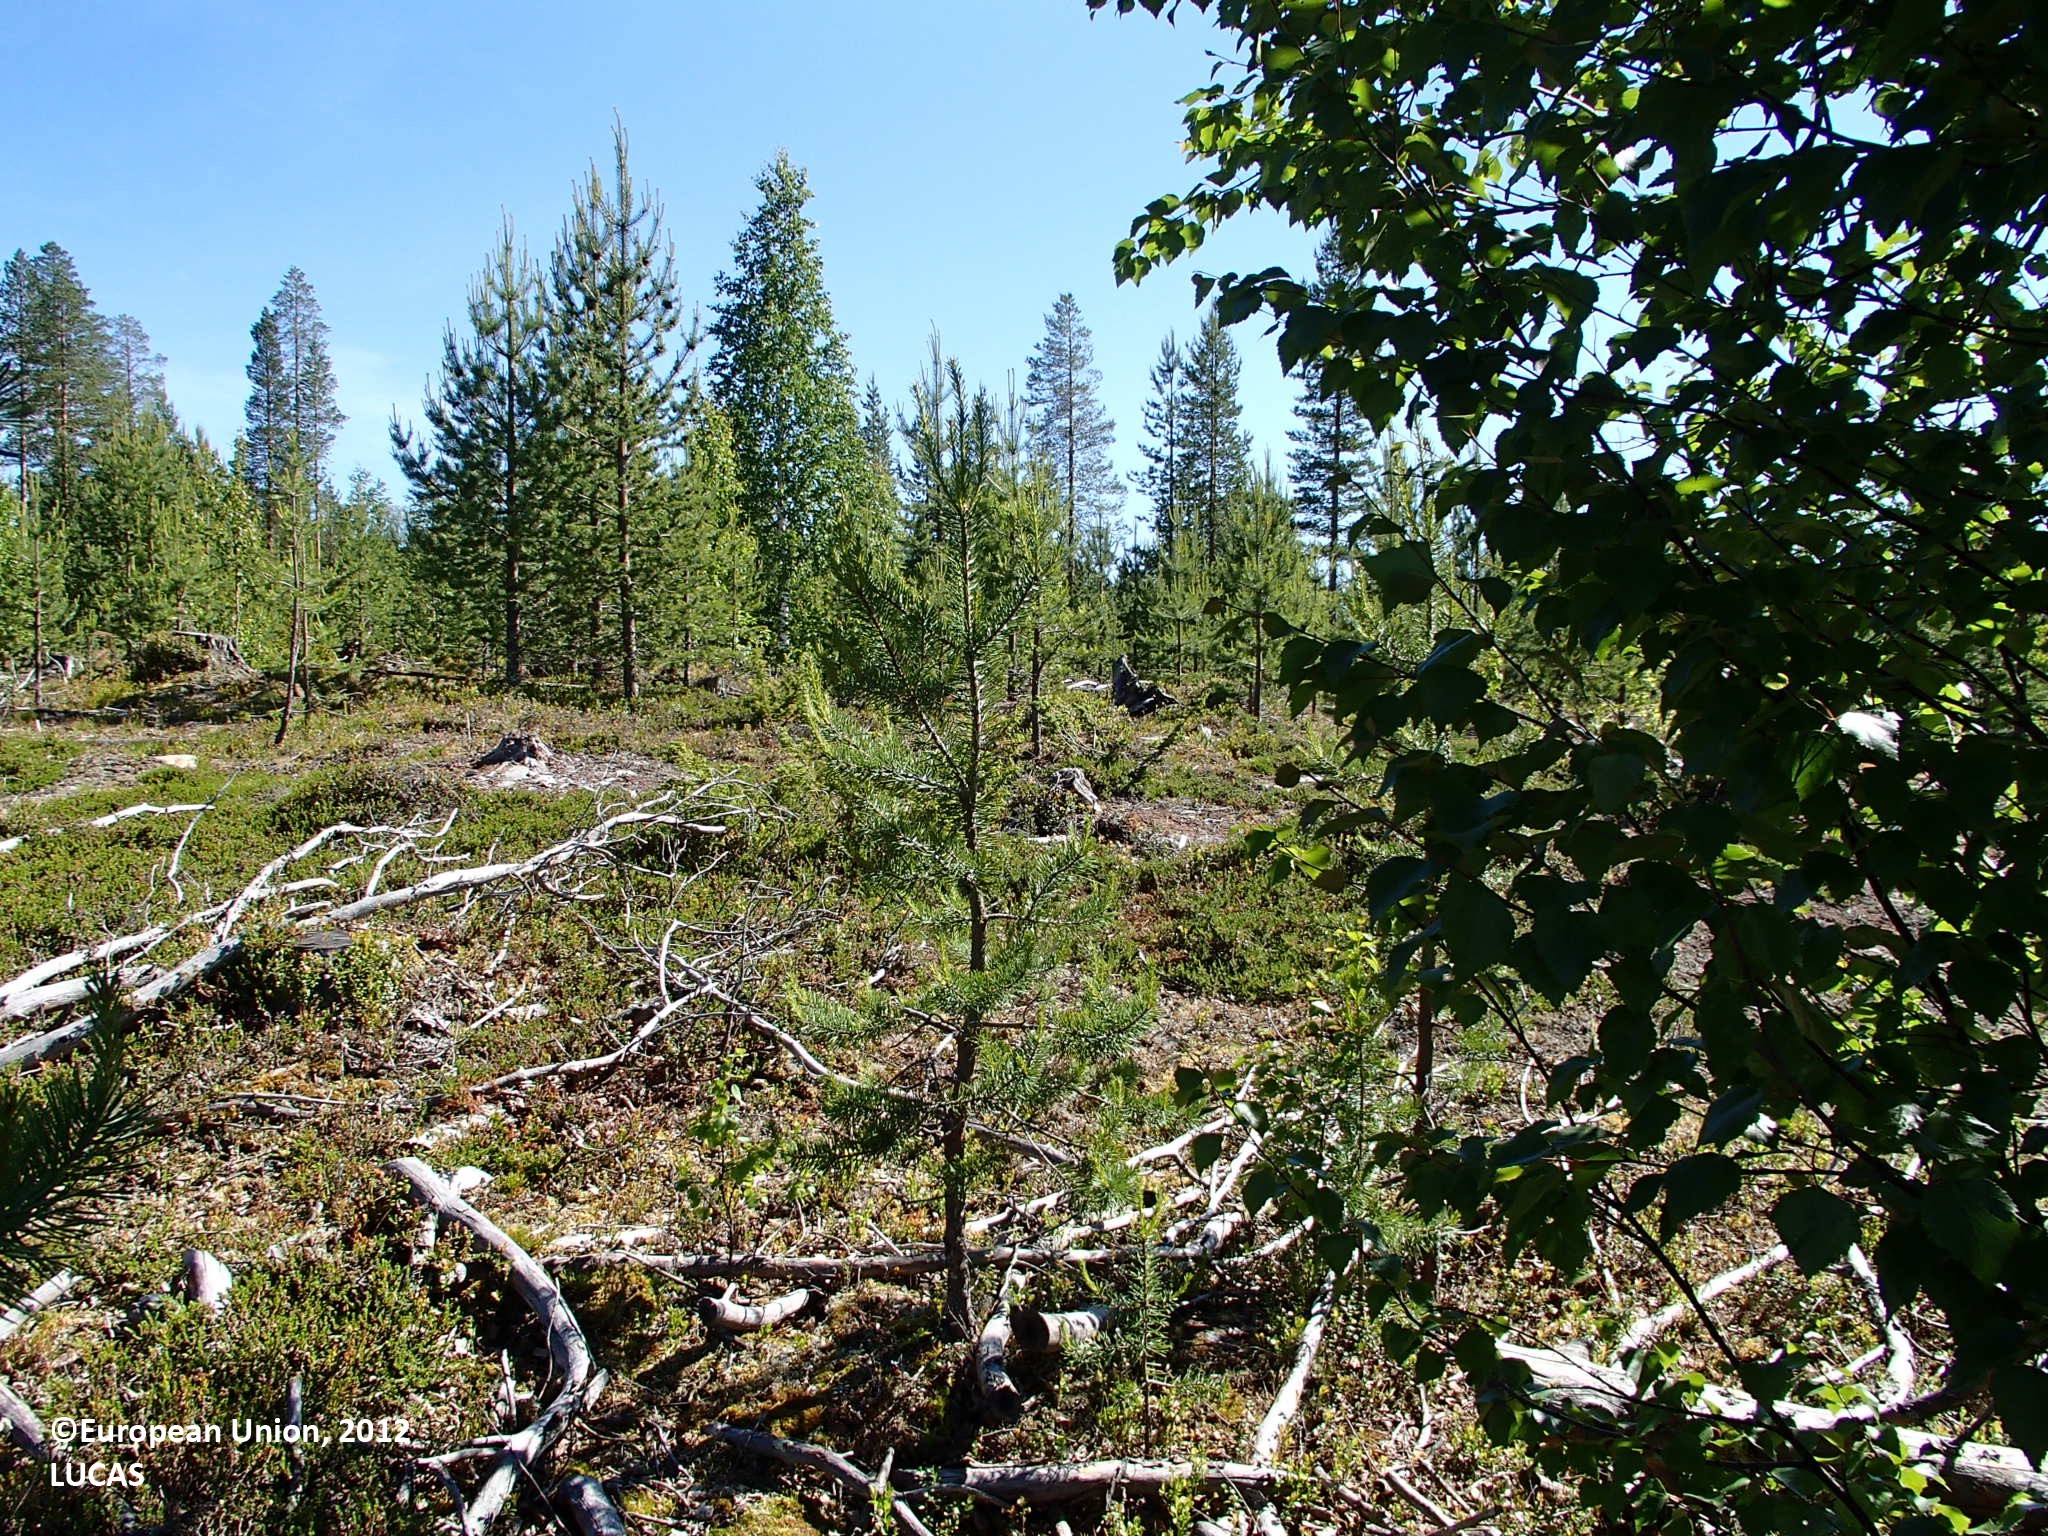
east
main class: Woodland
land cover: Other mixed woodland
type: boreal forest
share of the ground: 10 - 25 %
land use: Forestry
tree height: > 5 m
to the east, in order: Other mixed woodland; Pine dominated coniferous woodland
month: July
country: FI
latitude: 67.1153
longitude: 26.6497
